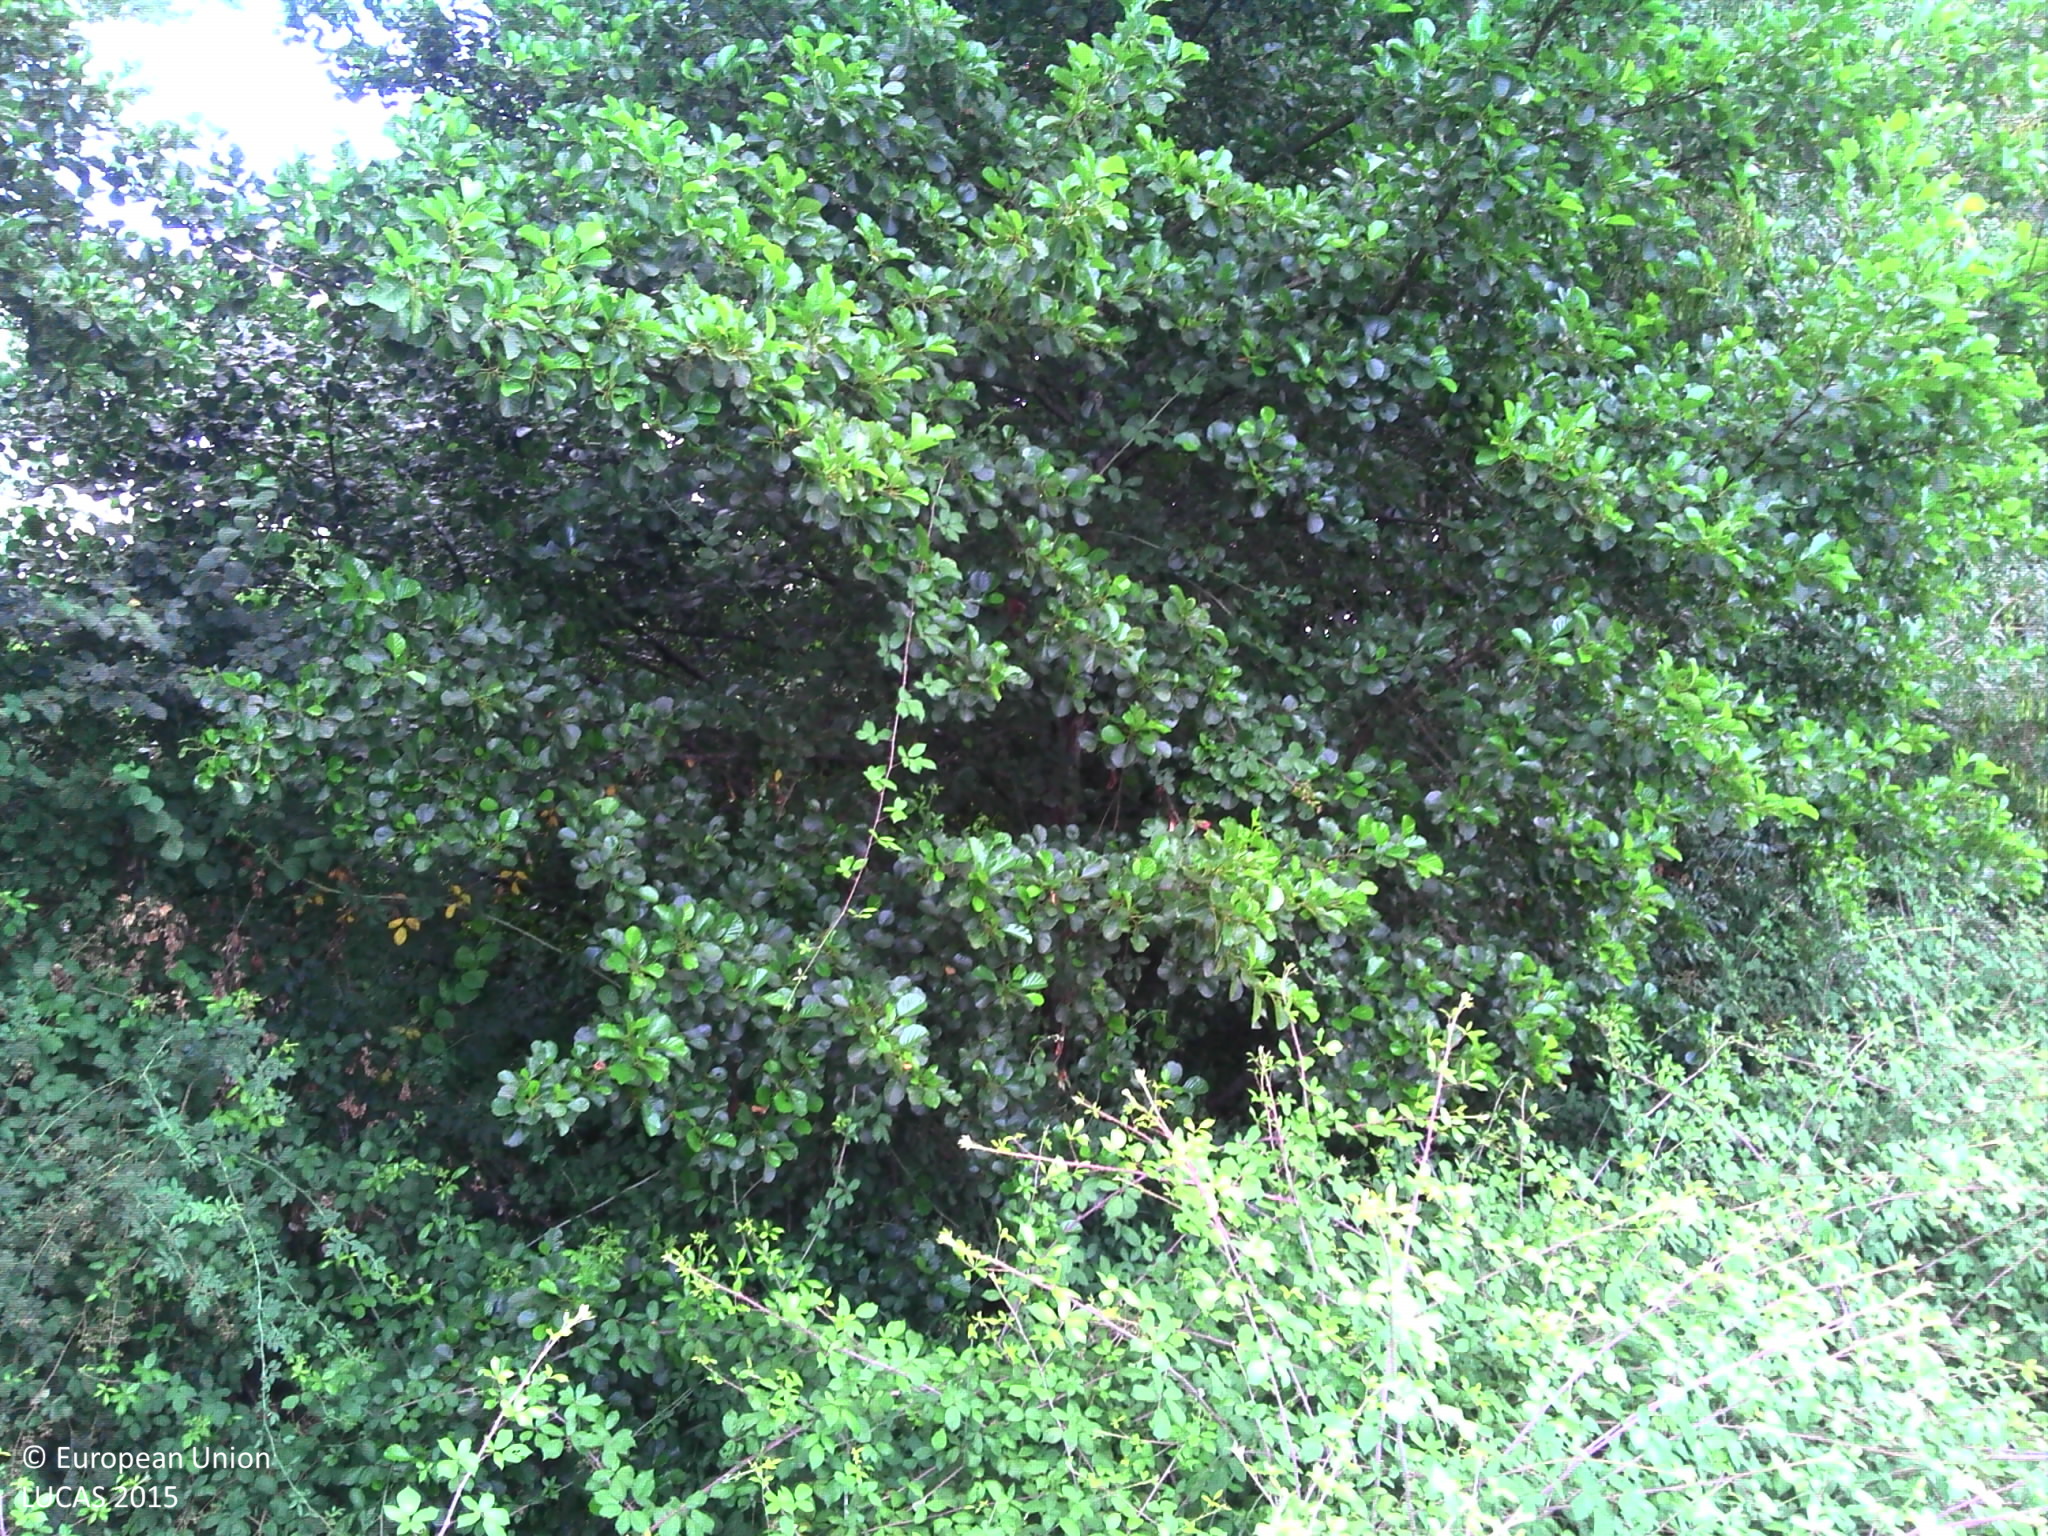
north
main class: Grassland
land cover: Spontaneously vegetated surfaces
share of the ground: > 75 %
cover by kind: unconsolidated bare surface 60 %, herbaceous plants 40 %
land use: Abandoned areas
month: July
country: FR
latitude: 44.4186
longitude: 0.6620
